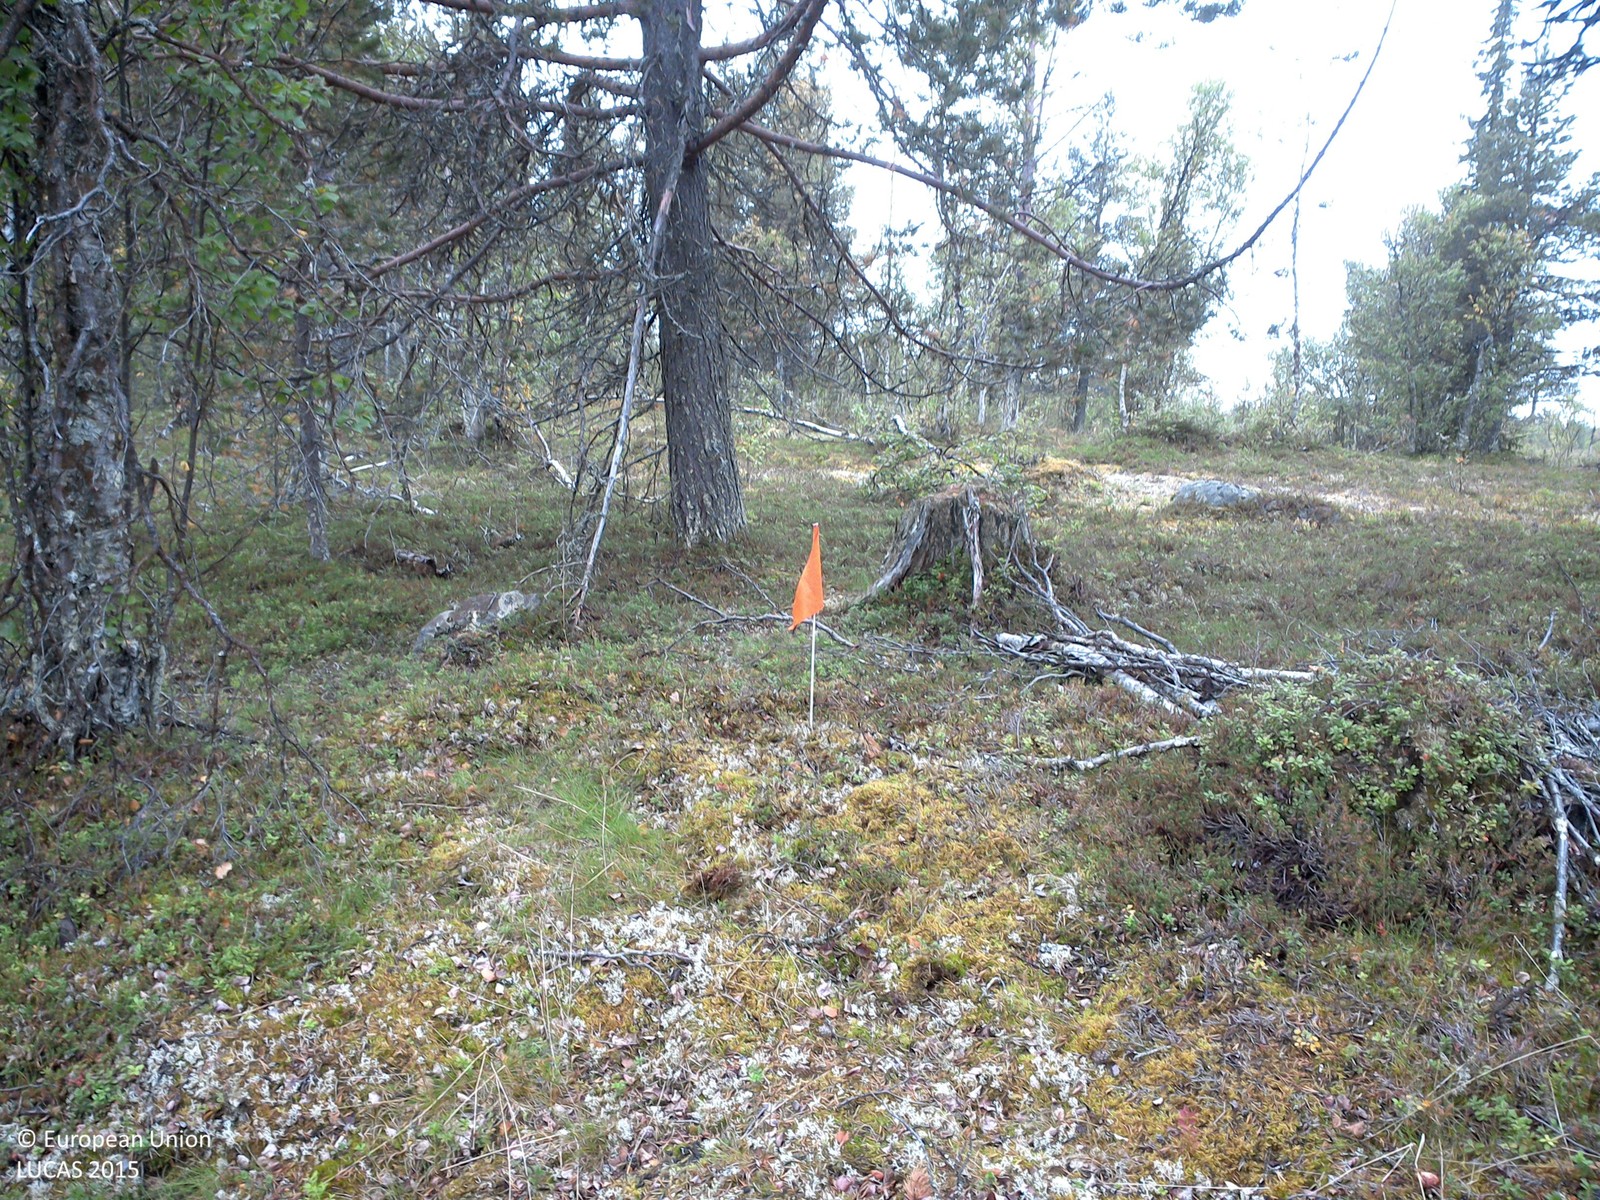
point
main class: Woodland
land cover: Pine dominated mixed woodland
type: boreal forest
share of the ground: 25 - 50 %
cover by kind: shrubs 50 %, lichens and mosses 25 %, coniferous forest trees 15 %, broadleaved forest trees 10 %
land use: Amenities, museums, leisure
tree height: > 5 m
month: August
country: SE
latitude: 67.9838
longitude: 21.6330
